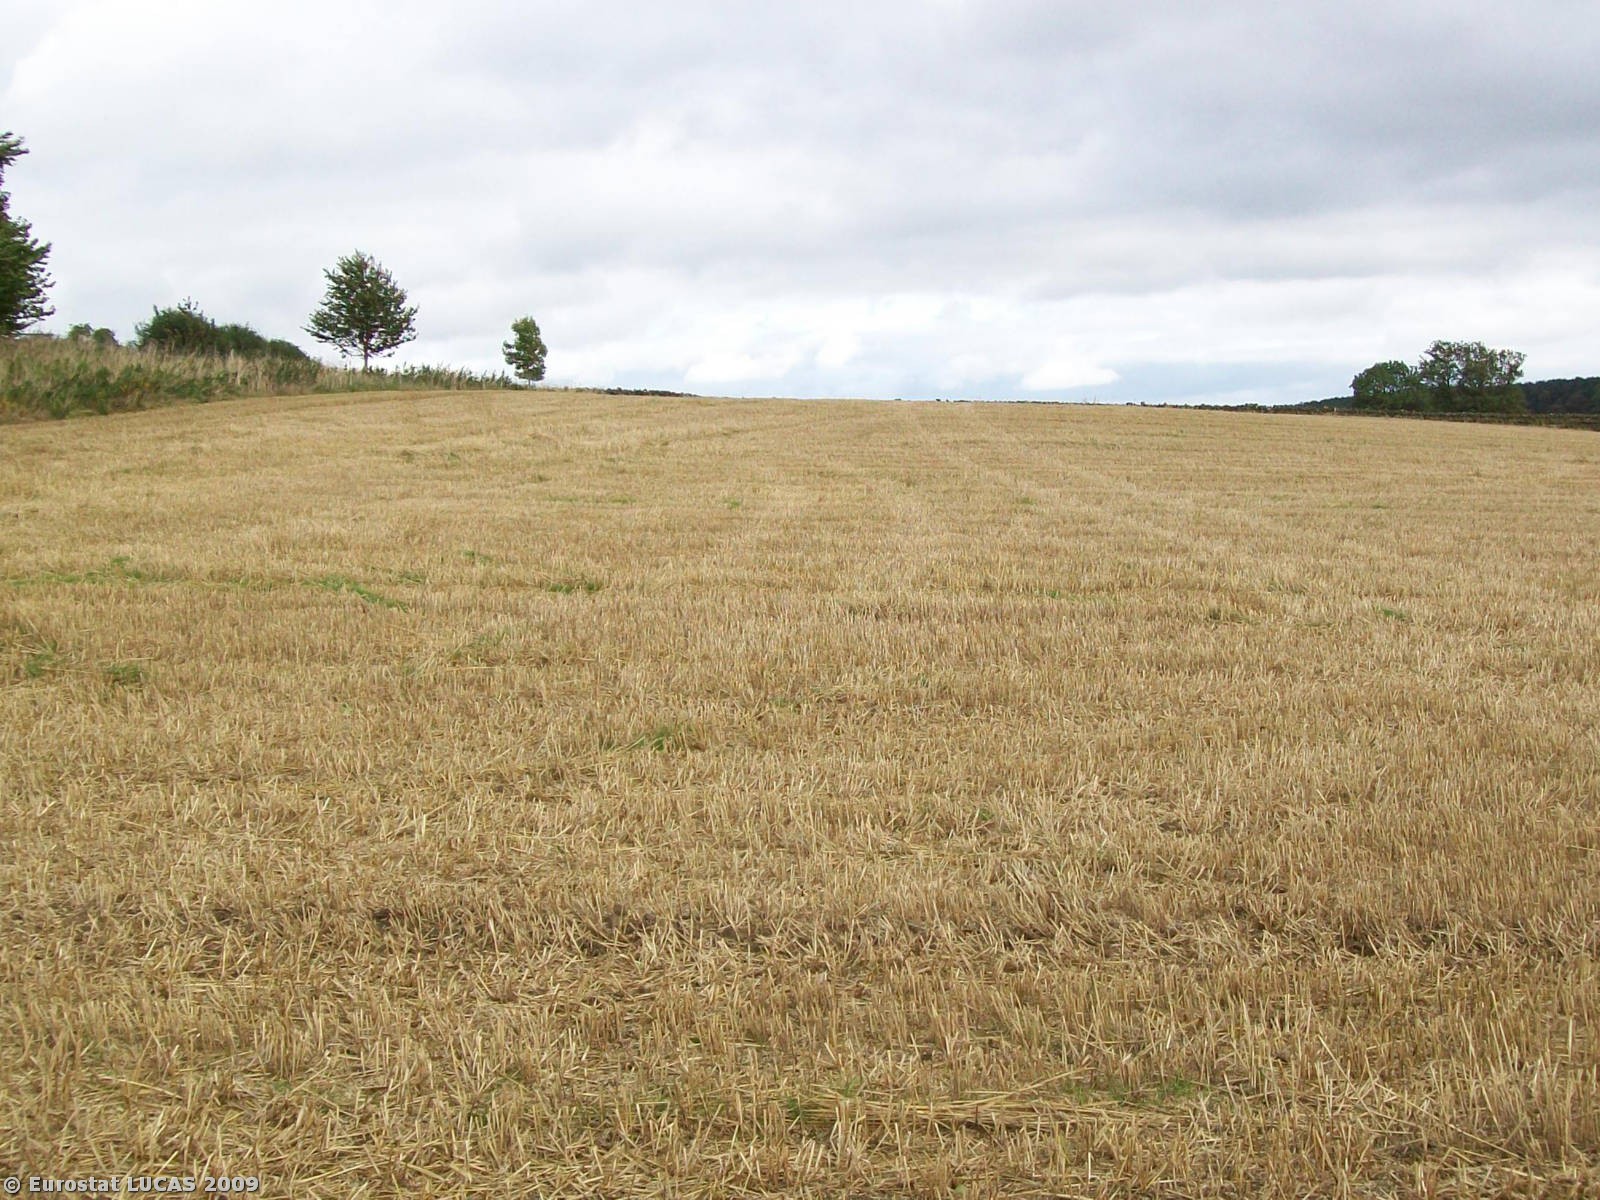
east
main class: Cropland
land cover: Common wheat
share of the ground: > 75 %
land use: Agriculture (excluding fallow land and kitchen gardens)
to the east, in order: Common wheat; Grass margins; Dry stone walls; Grass margins; Barley
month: September
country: GB
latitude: 55.0668
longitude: -2.0977
